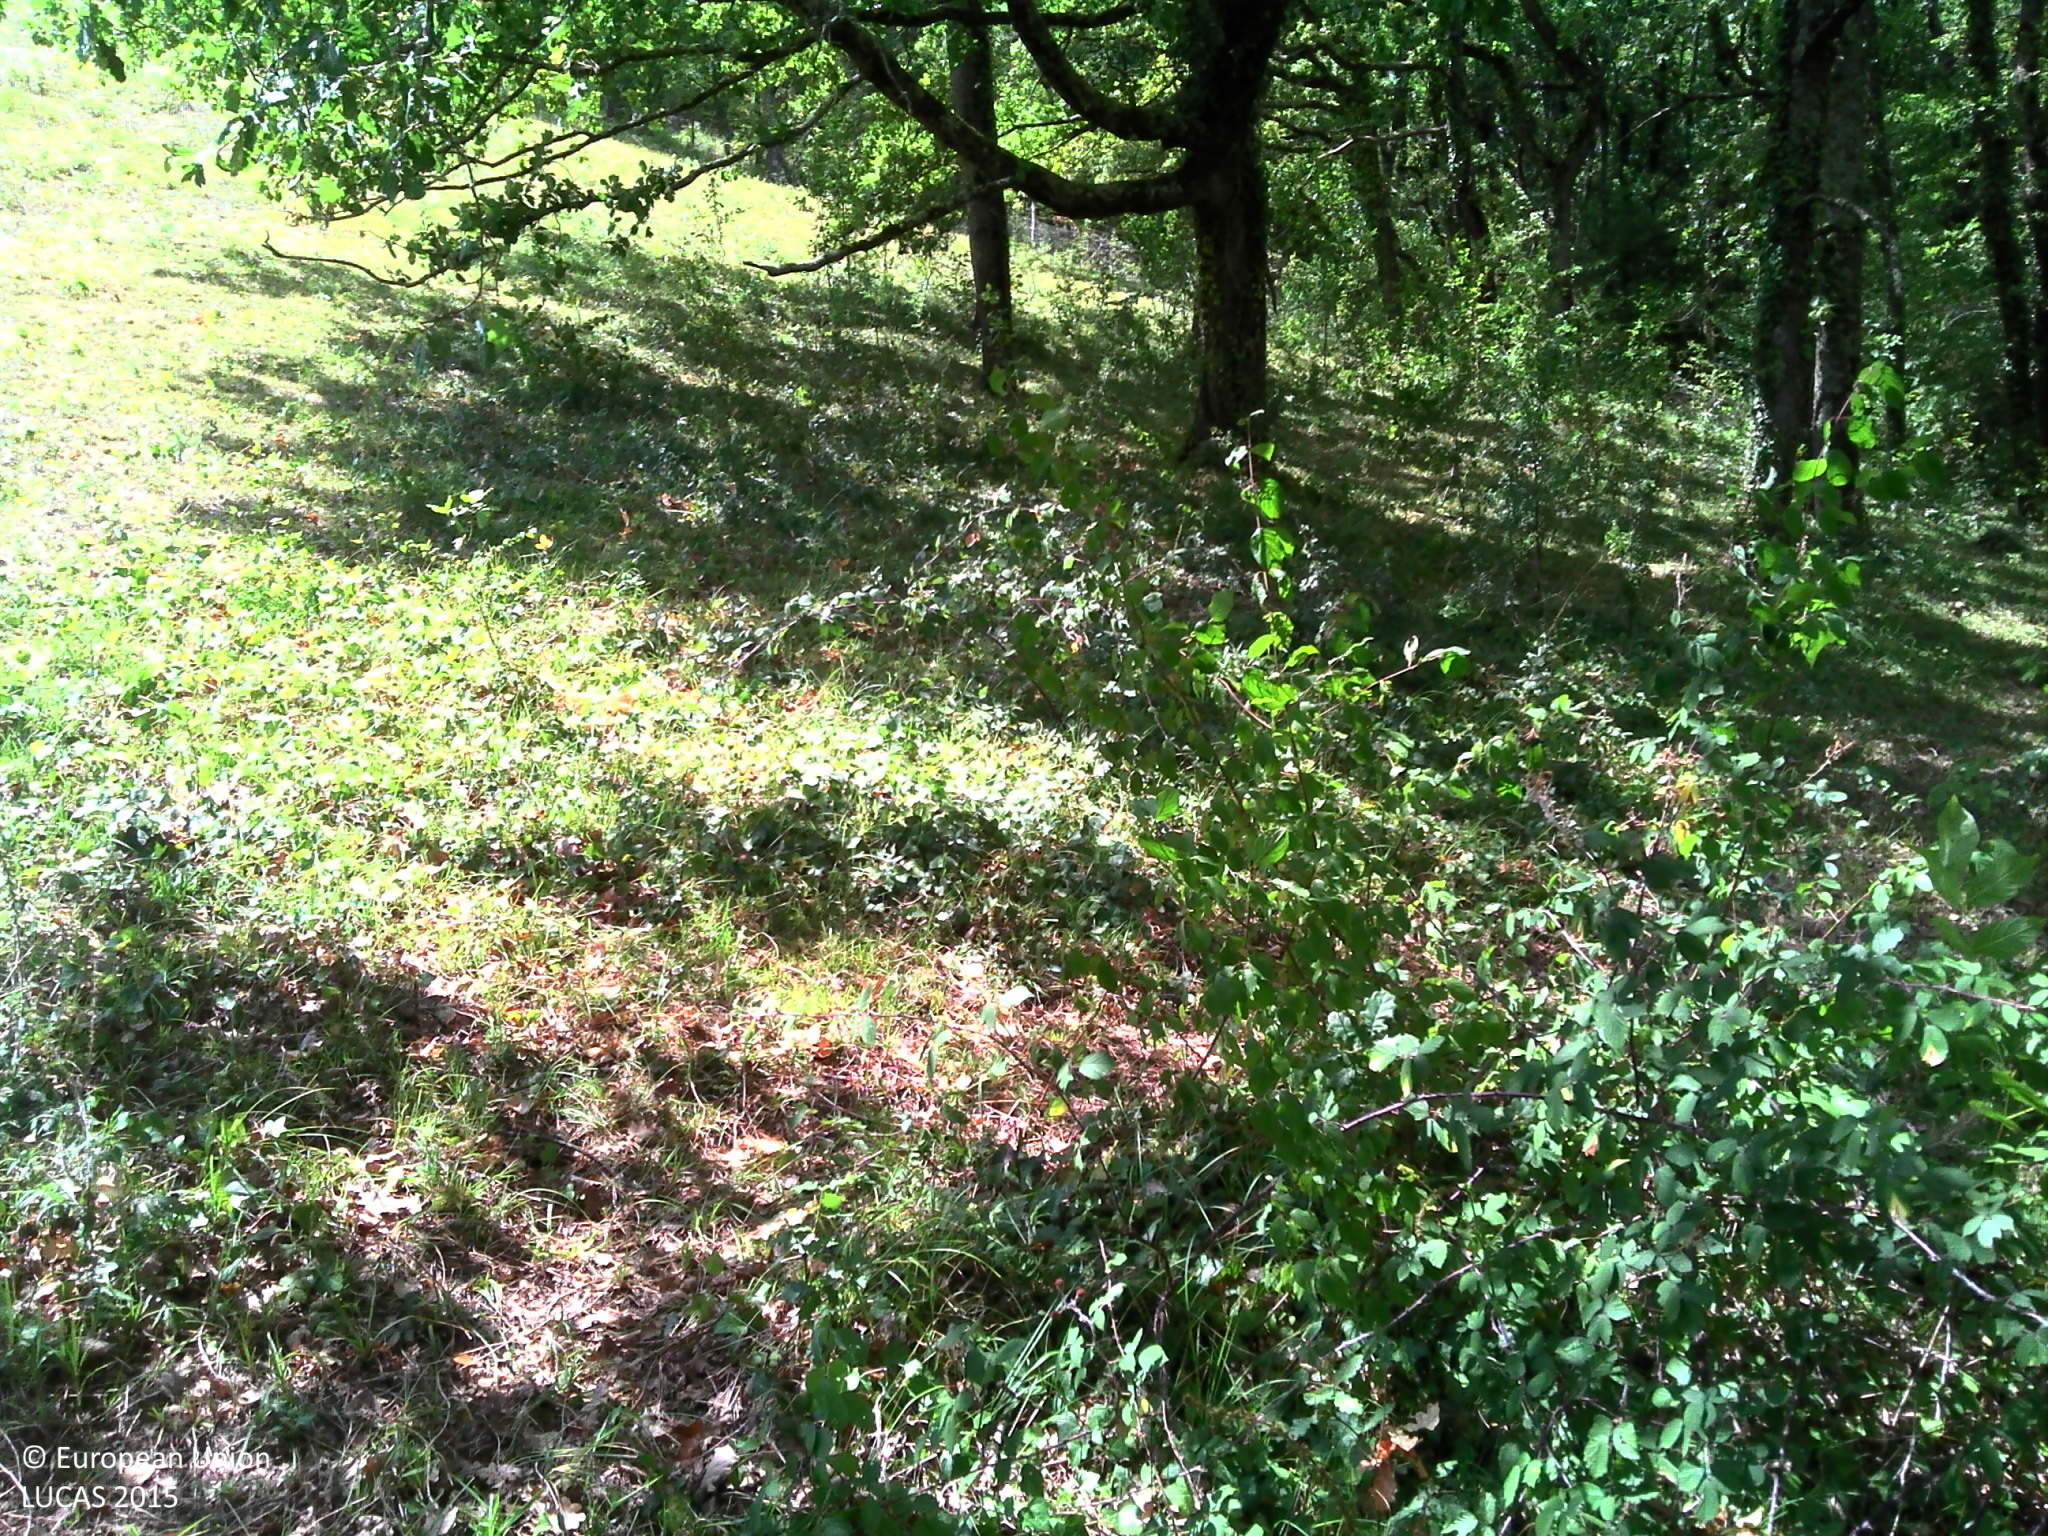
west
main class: Woodland
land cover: Broadleaved woodland
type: thermophilous deciduous forest
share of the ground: > 75 %
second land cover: Grassland without tree/shrub cover
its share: > 75 %
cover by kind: broadleaved forest trees 65 %, herbaceous plants 35 %
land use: Forestry
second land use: Agriculture (excluding fallow land and kitchen gardens)
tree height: > 5 m
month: July
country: FR
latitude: 44.3738
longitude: 0.5684
